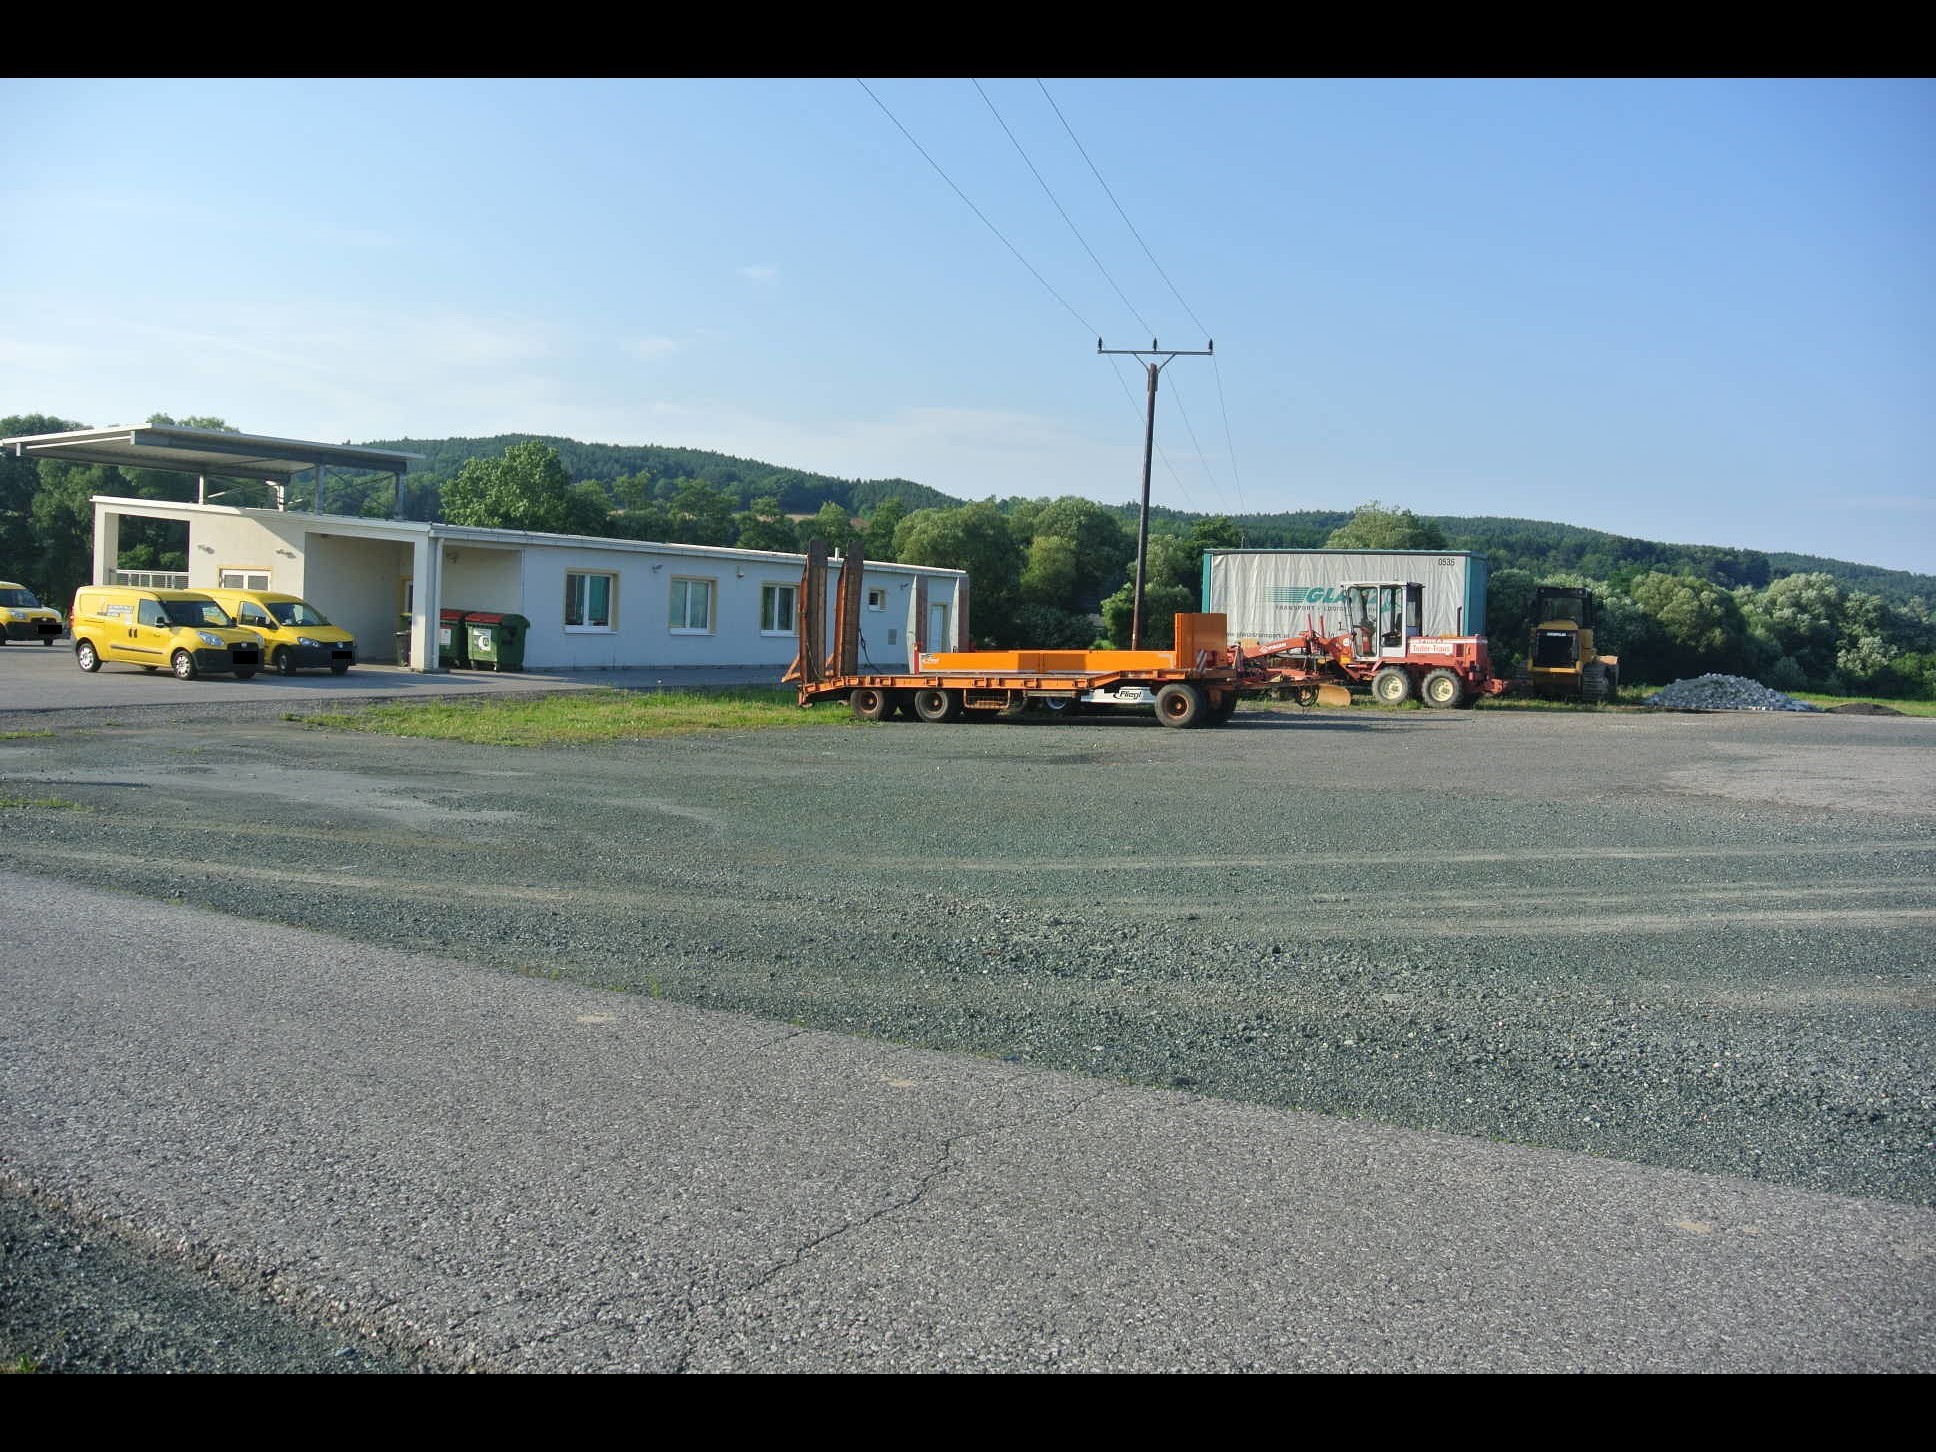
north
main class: Cropland
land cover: Oats
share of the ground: > 75 %
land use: Agriculture (excluding fallow land and kitchen gardens)
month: July
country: AT
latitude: 47.4070
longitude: 16.3773
